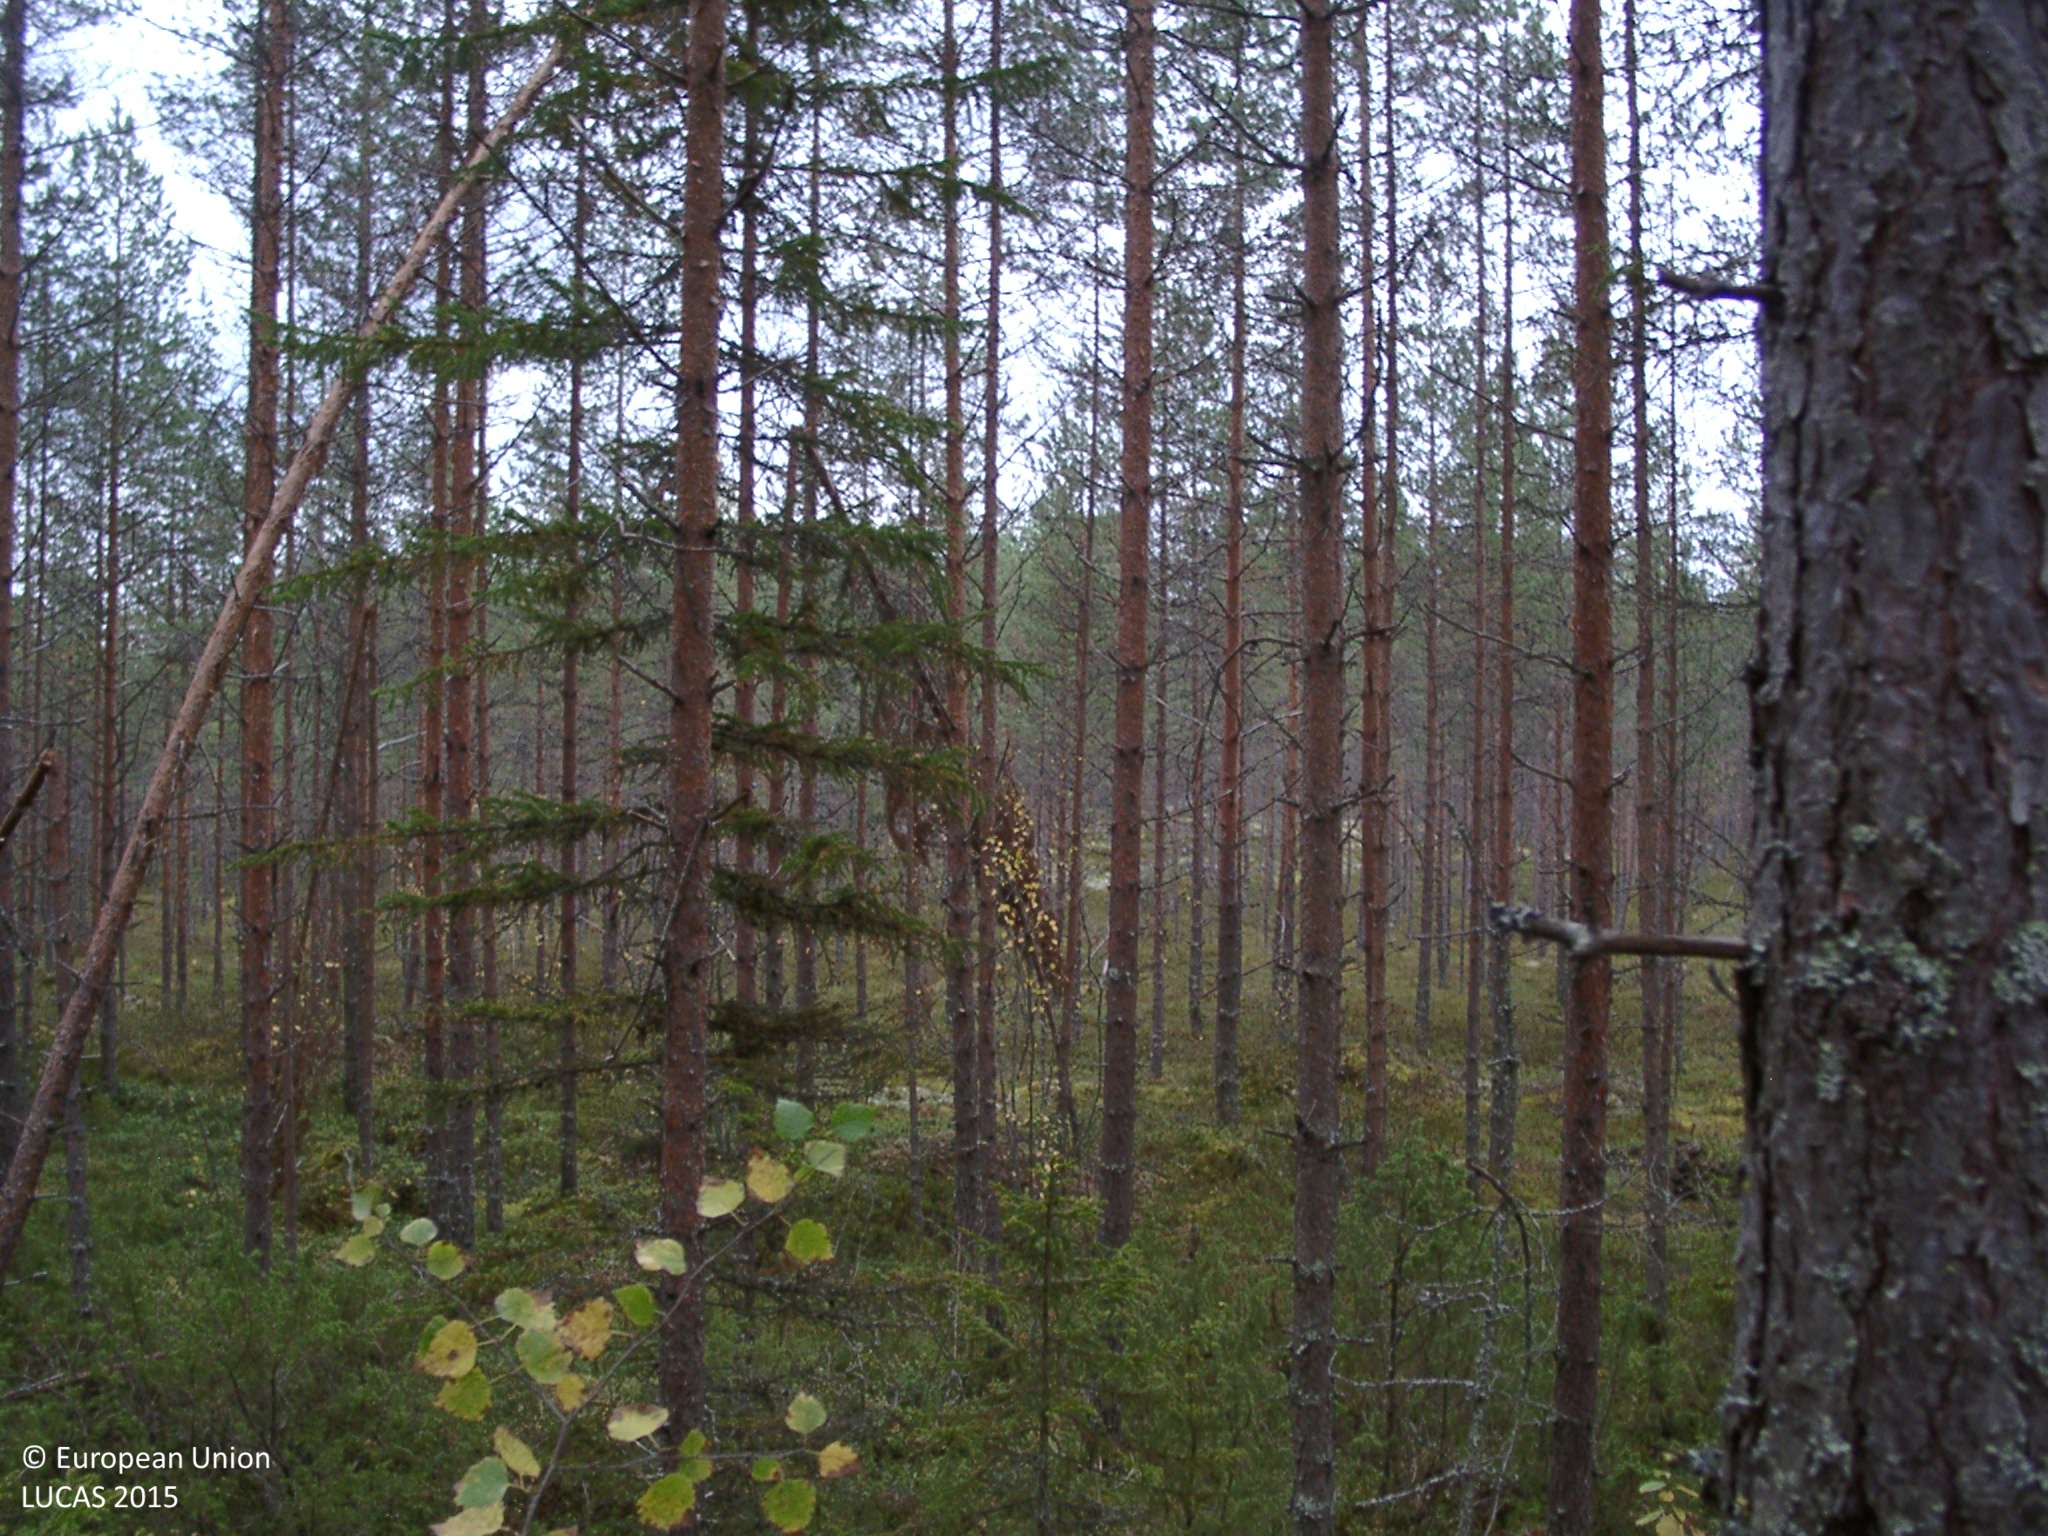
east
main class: Woodland
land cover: Pine dominated coniferous woodland
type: boreal forest
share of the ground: 50 - 75 %
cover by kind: coniferous forest trees 60 %, lichens and mosses 25 %, shrubs 15 %
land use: Forestry
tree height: > 5 m
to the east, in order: Pine dominated coniferous woodland; Ditches and canals; Pine dominated coniferous woodland; Ditches and canals; Pine dominated coniferous woodland; Ditches and canals; Pine dominated coniferous woodland; Ditches and canals; Pine dominated coniferous woodland; Ditches and canals; Pine dominated coniferous woodland; Ditches and canals; Pine dominated coniferous woodland
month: September
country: FI
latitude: 62.8142
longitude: 25.3491
